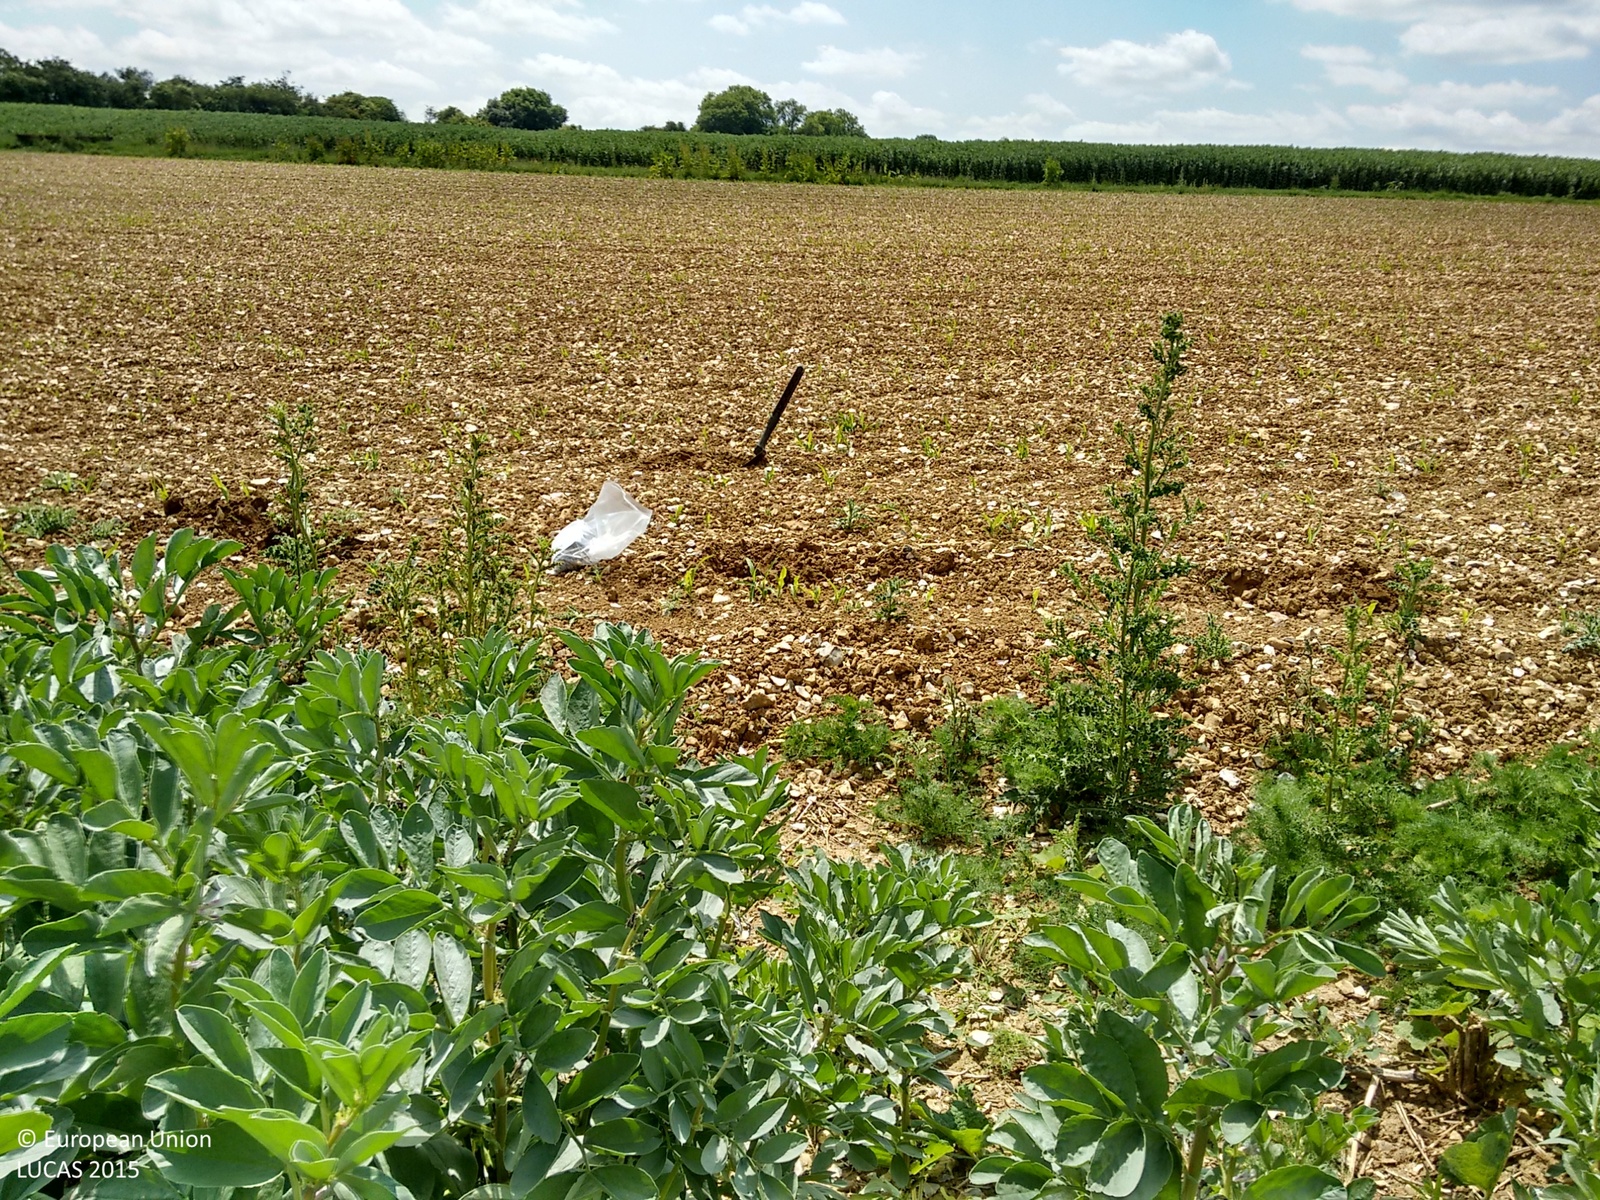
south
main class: Cropland
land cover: Dry pulses
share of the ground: > 75 %
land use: Agriculture (excluding fallow land and kitchen gardens)
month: June
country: GB
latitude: 51.4744
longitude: -1.4679
